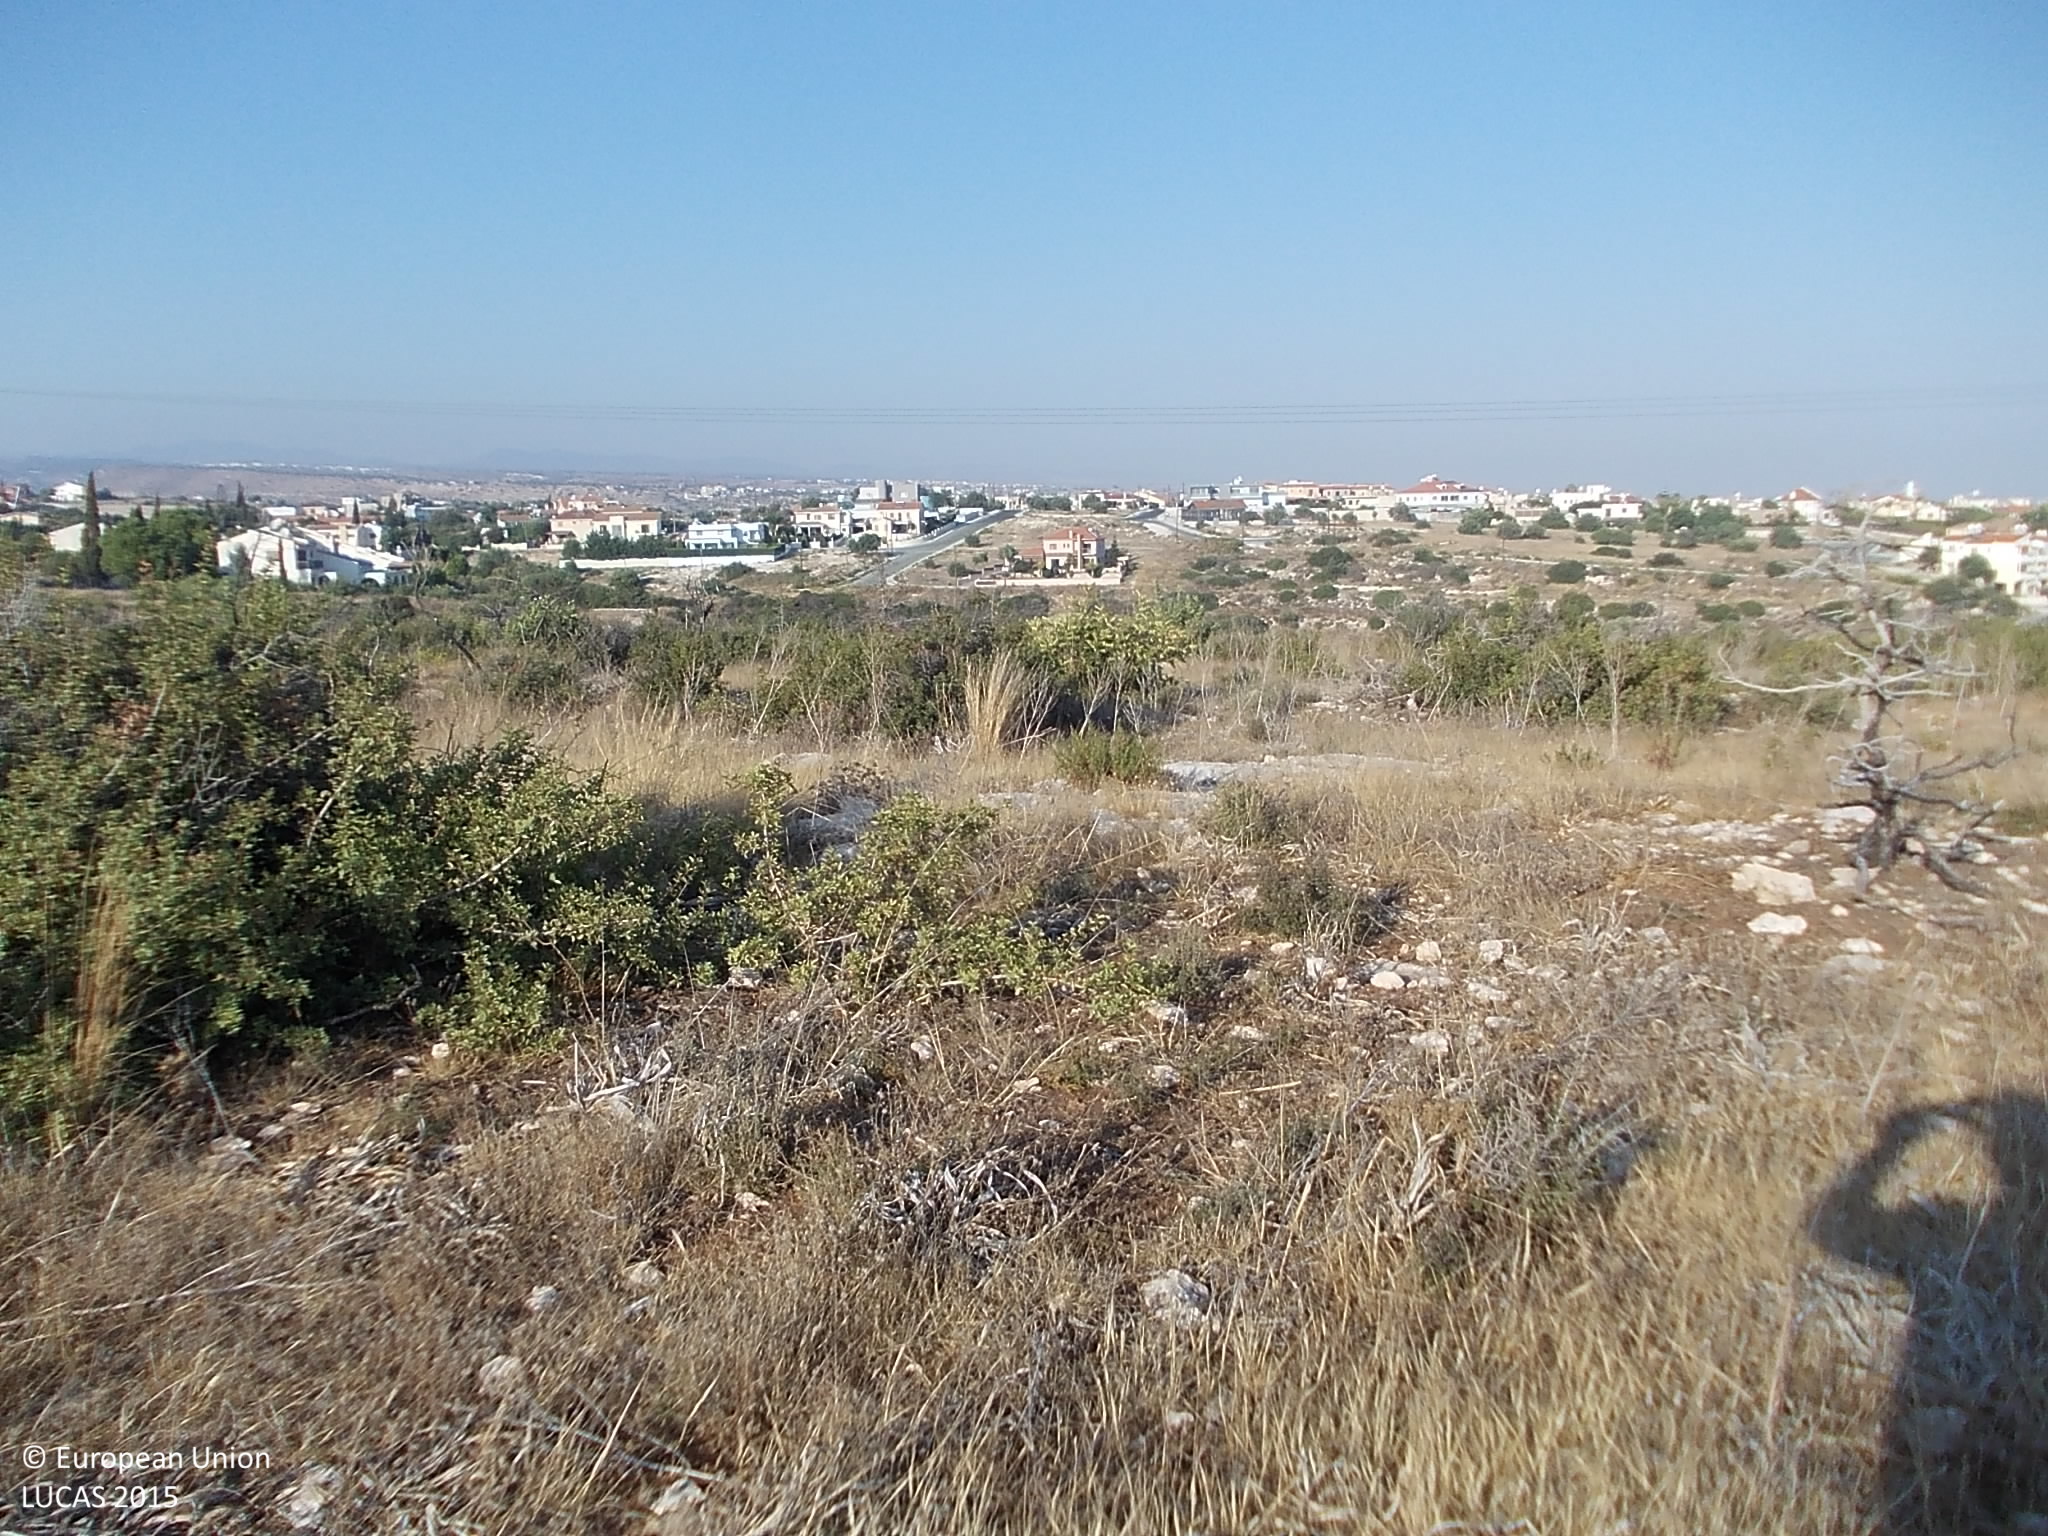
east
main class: Shrubland
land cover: Shrubland without tree cover
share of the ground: 25 - 50 %
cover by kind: herbaceous plants 50 %, shrubs 40 %, unconsolidated bare surface 10 %
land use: Semi-natural and natural areas not in use
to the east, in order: Shrubland without tree cover; Electric lines; Shrubland without tree cover; Tracks; Shrubland without tree cover; Paved roads, cycling and walking lanes; Shrubland without tree cover; Paved roads, cycling and walking lanes; Grassland without tree/shrub cover
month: September
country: CY
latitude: 34.6718
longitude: 32.8912
